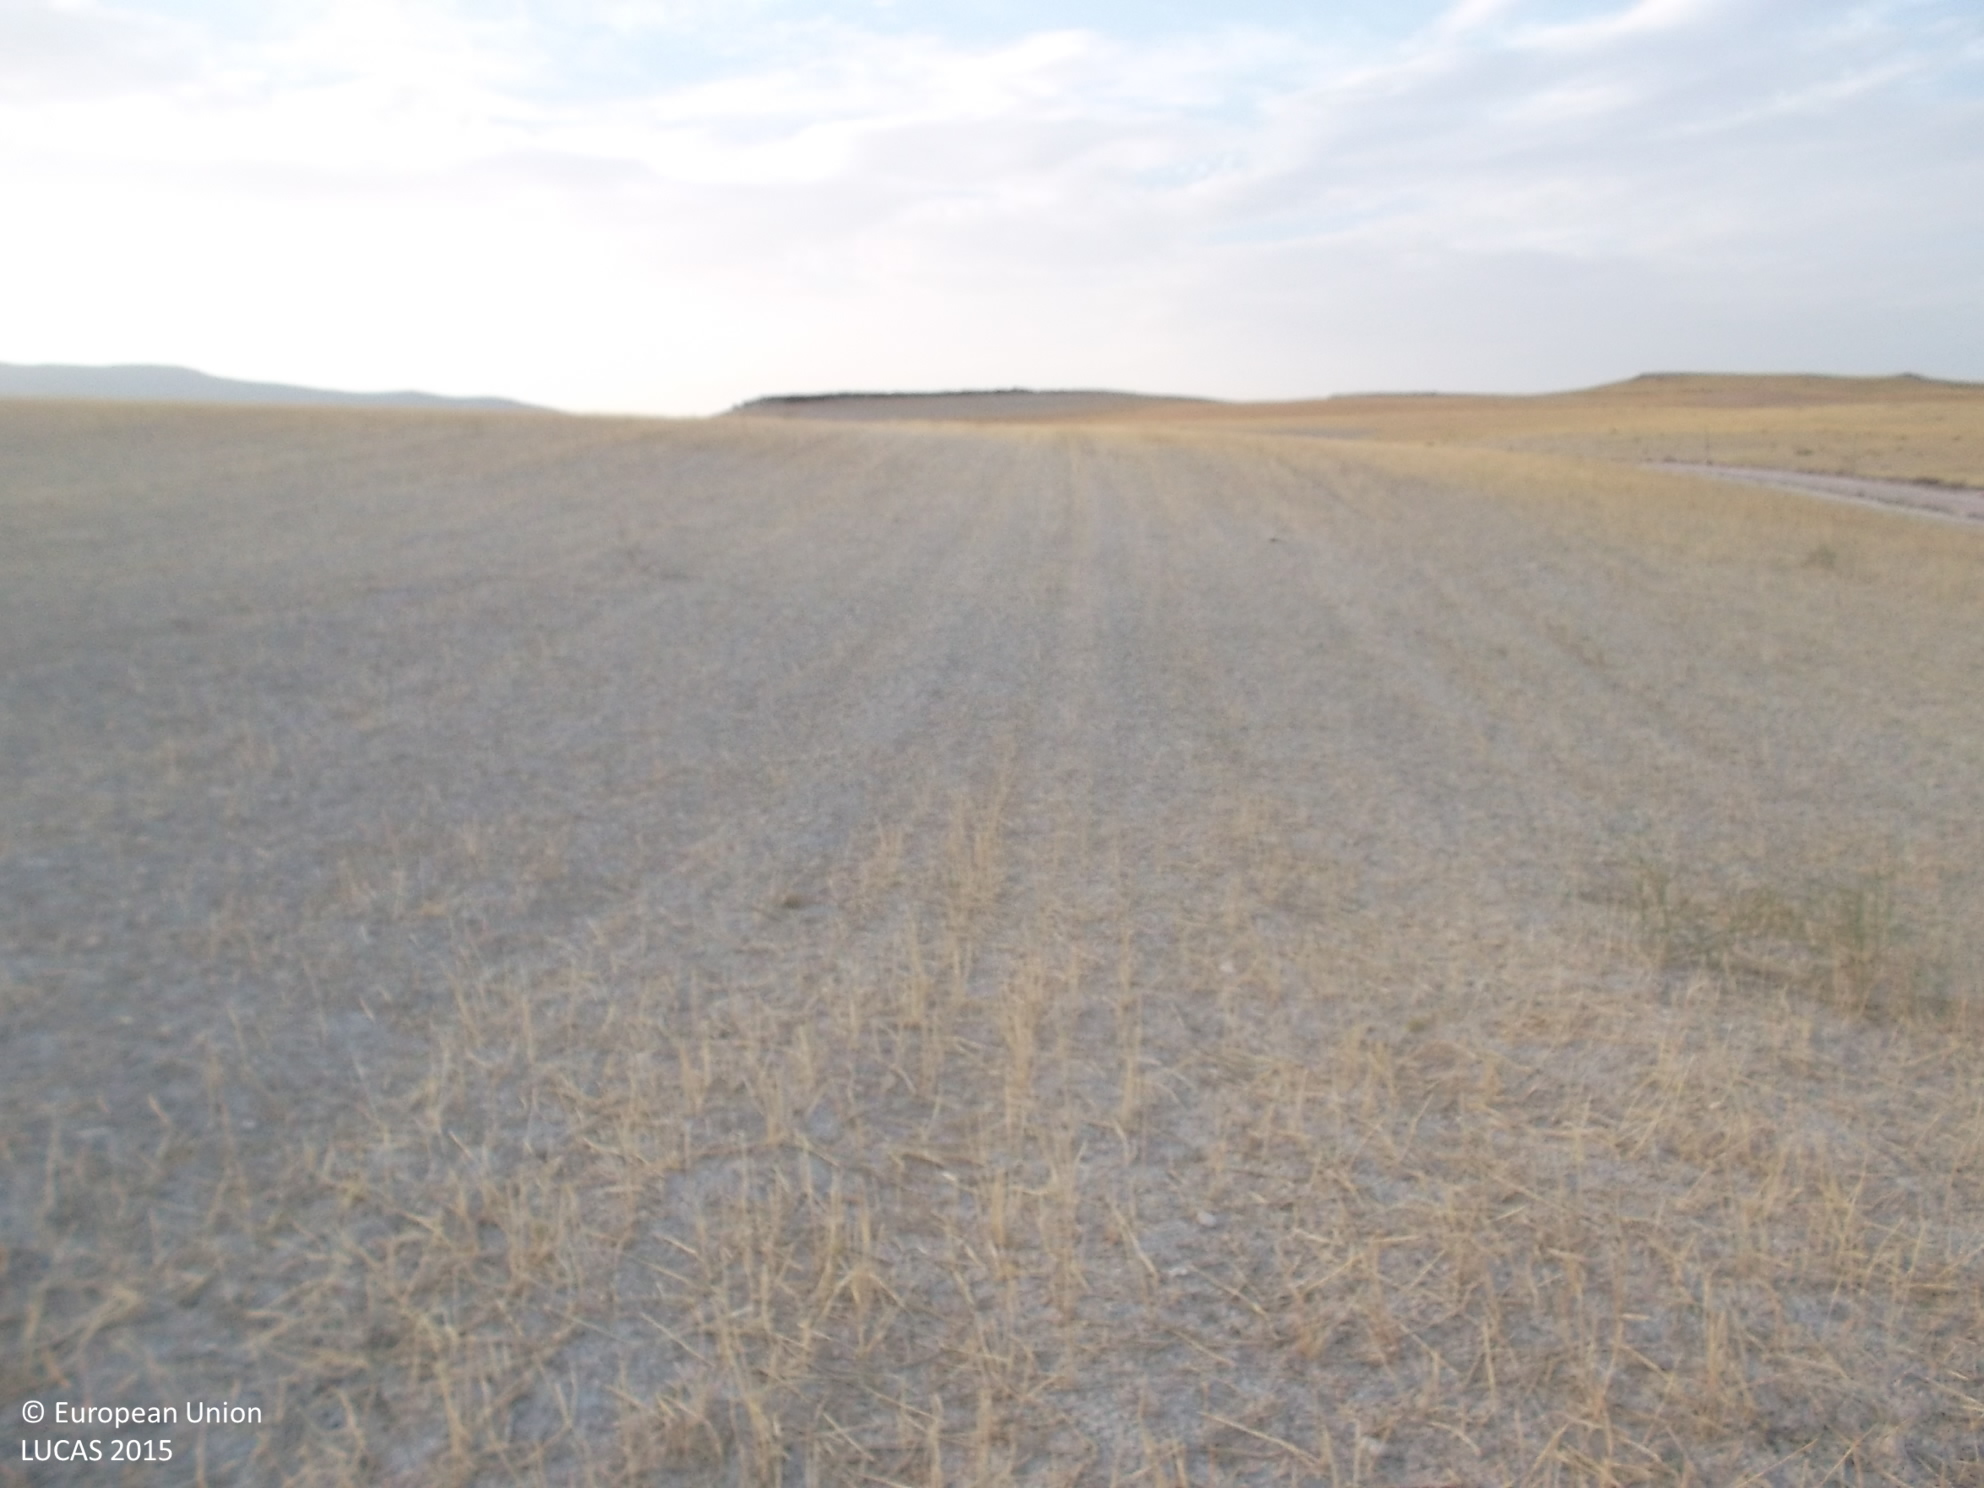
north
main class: Cropland
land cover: Barley
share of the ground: > 75 %
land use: Agriculture (excluding fallow land and kitchen gardens)
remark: Harvested field
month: July
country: ES
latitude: 37.7878
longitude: -2.4456
